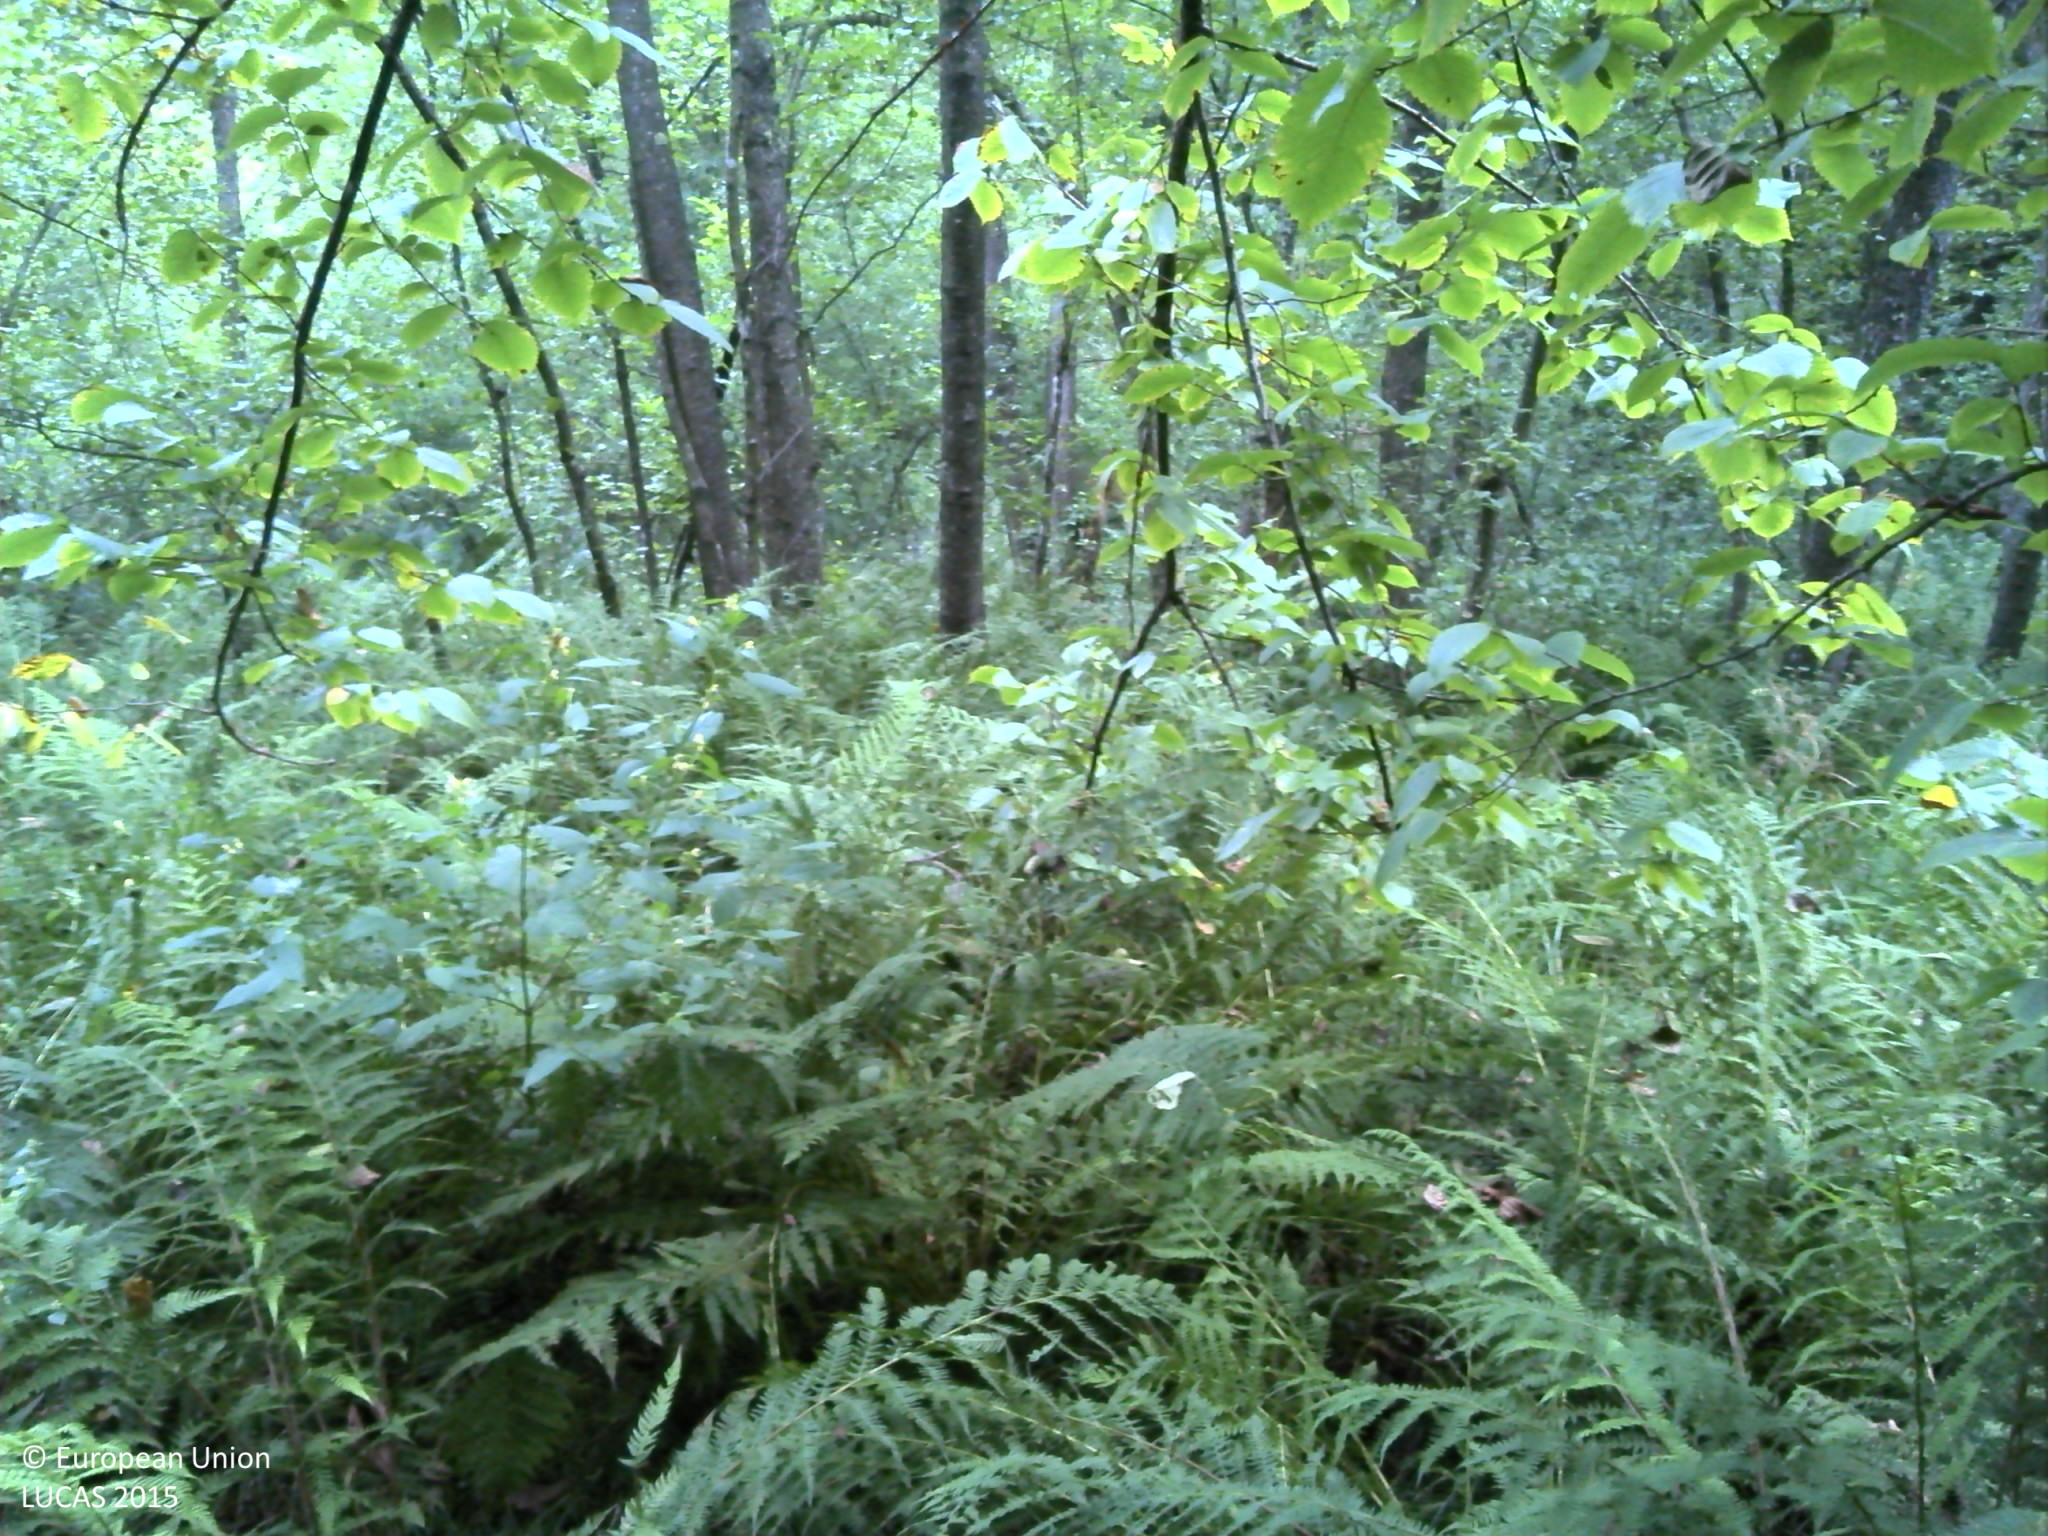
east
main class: Woodland
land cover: Broadleaved woodland
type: acidophilous oak and oak-birch forest
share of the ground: > 75 %
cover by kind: broadleaved forest trees 100 %
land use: Forestry
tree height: > 5 m
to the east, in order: Broadleaved woodland; Grassland with sparse tree/shrub cover; Tracks; Grassland with sparse tree/shrub cover
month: August
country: HR
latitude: 45.3212
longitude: 15.9030
